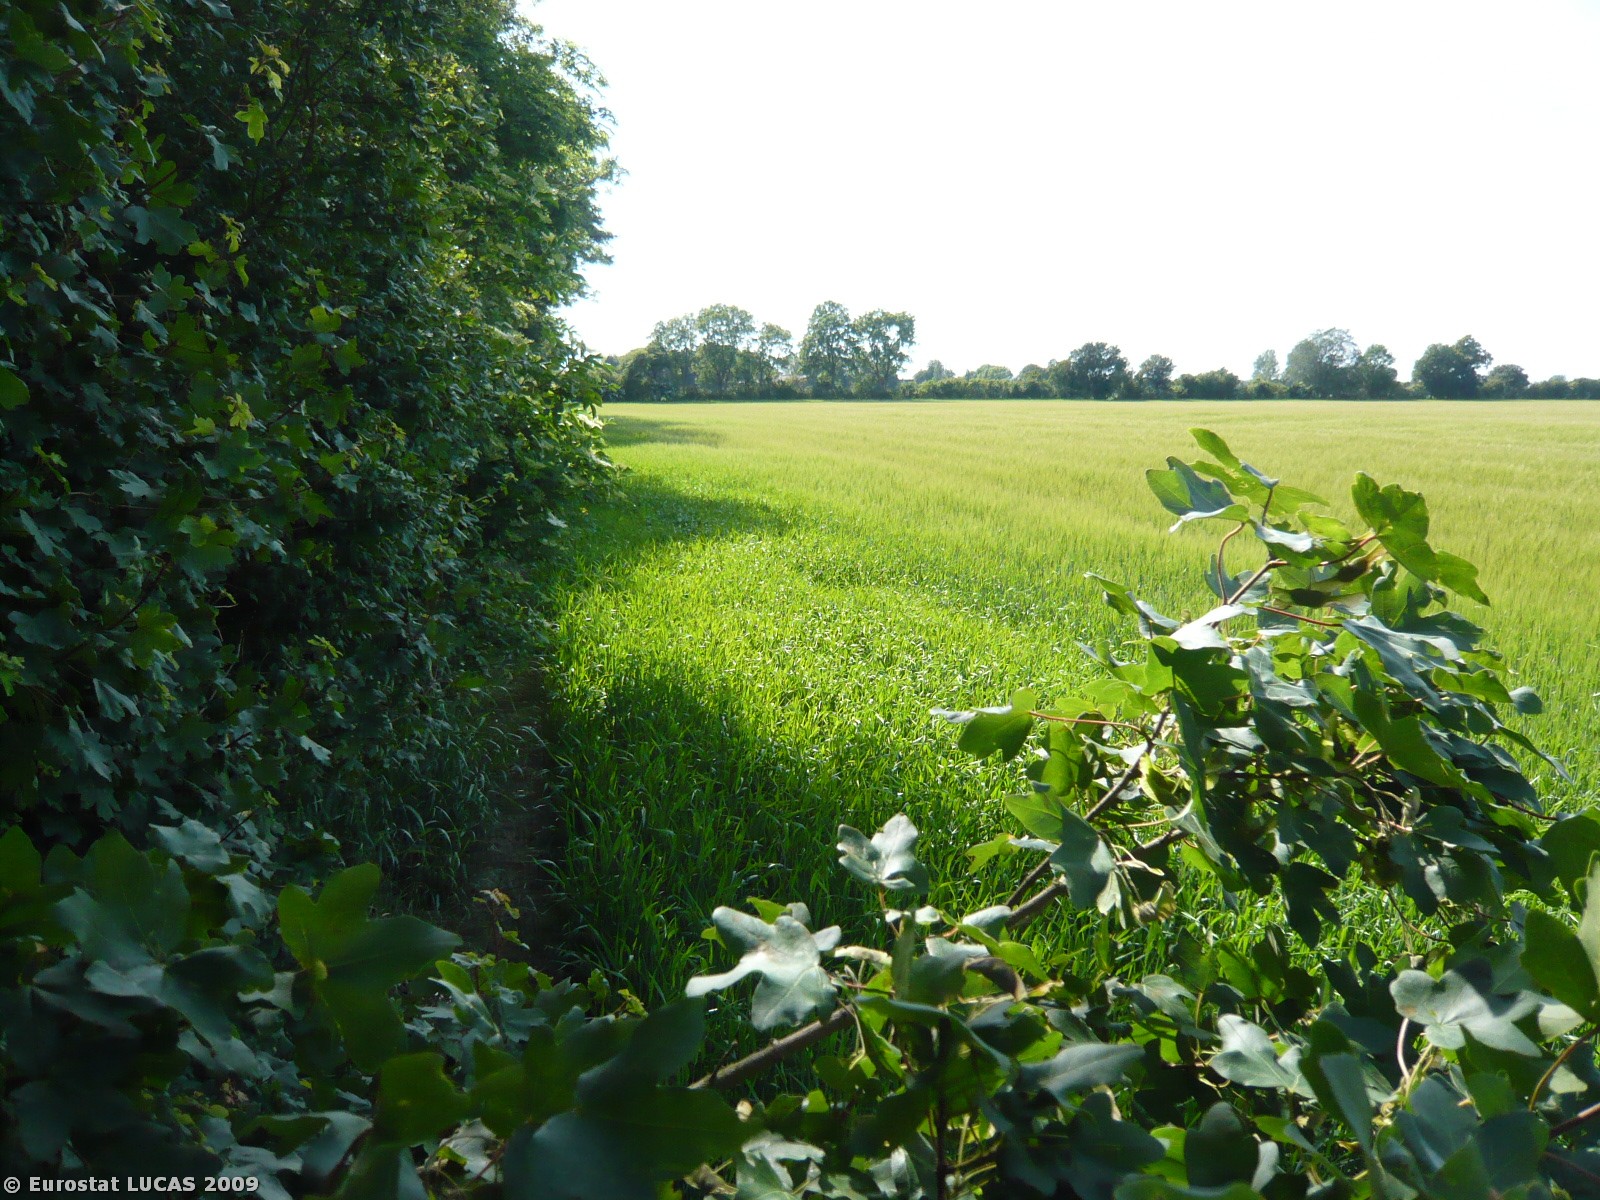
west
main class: Cropland
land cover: Barley
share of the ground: > 75 %
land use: Agriculture (excluding fallow land and kitchen gardens)
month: June
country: DK
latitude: 54.7791
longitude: 11.2896
